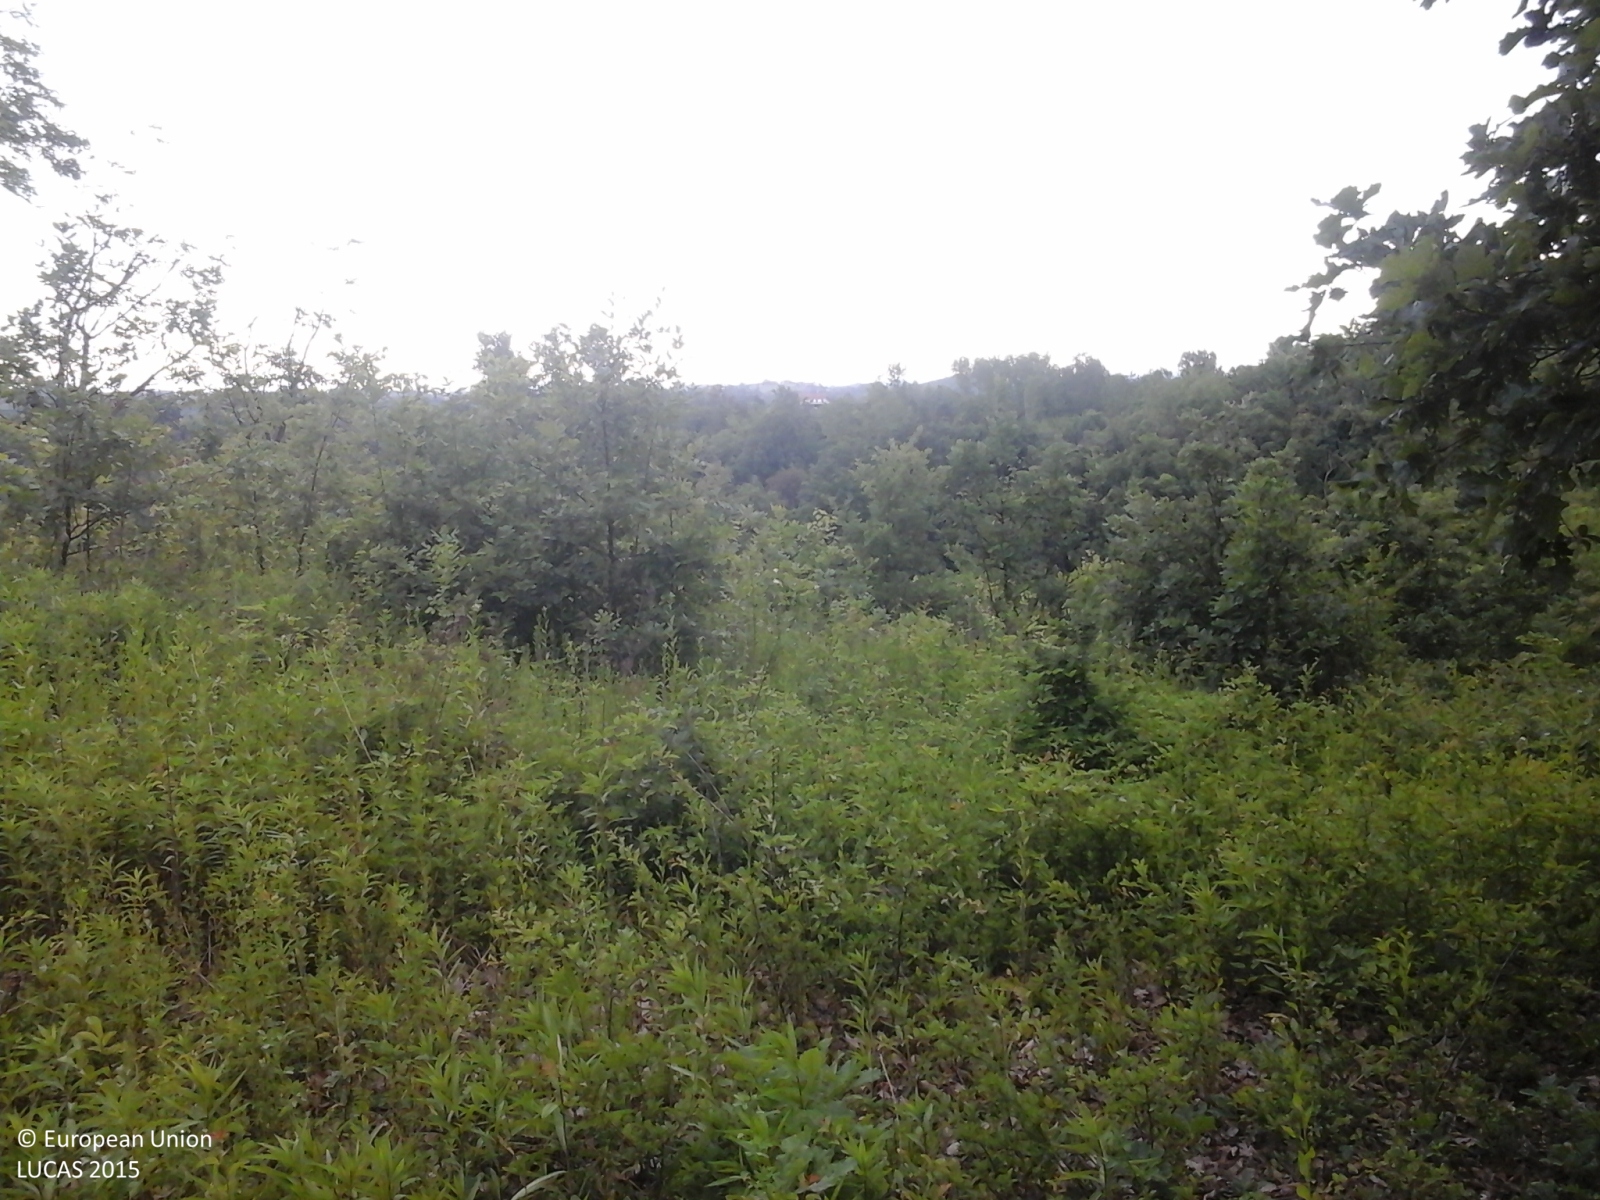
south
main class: Woodland
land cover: Broadleaved woodland
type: thermophilous deciduous forest
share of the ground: > 75 %
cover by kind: broadleaved forest trees 95 %, shrubs 5 %
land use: Semi-natural and natural areas not in use
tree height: > 5 m
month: May
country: IT
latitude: 44.8596
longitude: 8.2949
